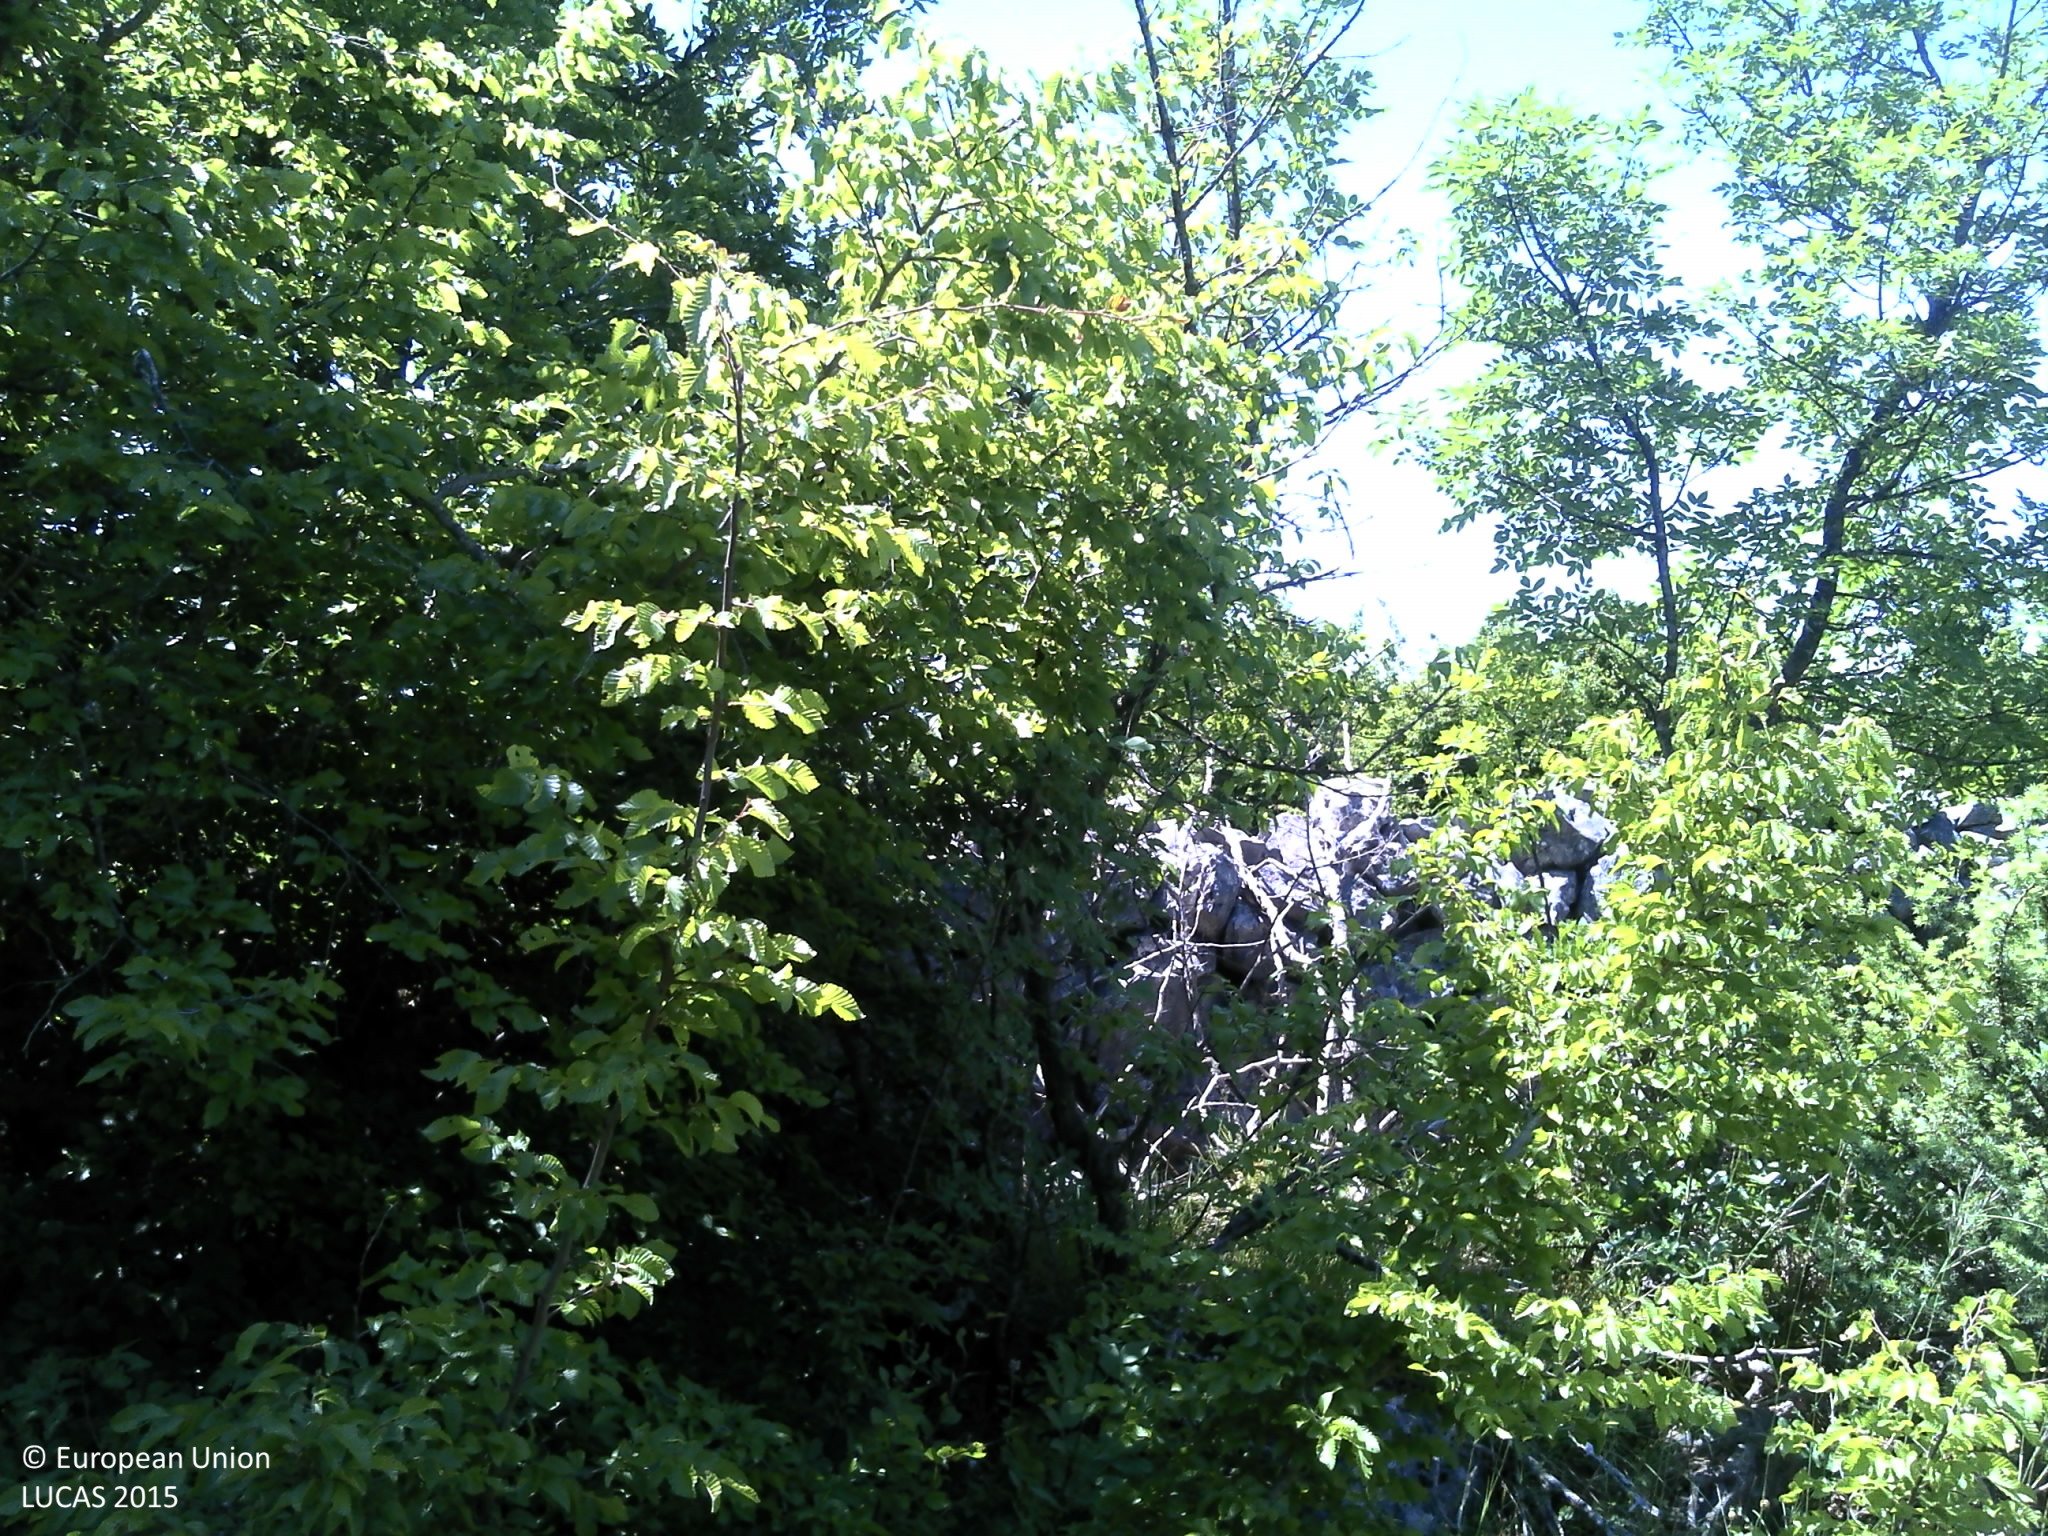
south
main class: Woodland
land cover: Broadleaved woodland
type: thermophilous deciduous forest
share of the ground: > 75 %
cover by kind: broadleaved forest trees 75 %, herbaceous plants 15 %, shrubs 5 %, unconsolidated bare surface 5 %
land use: Semi-natural and natural areas not in use
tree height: < 5 m
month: June
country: HR
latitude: 43.7468
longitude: 16.2378
